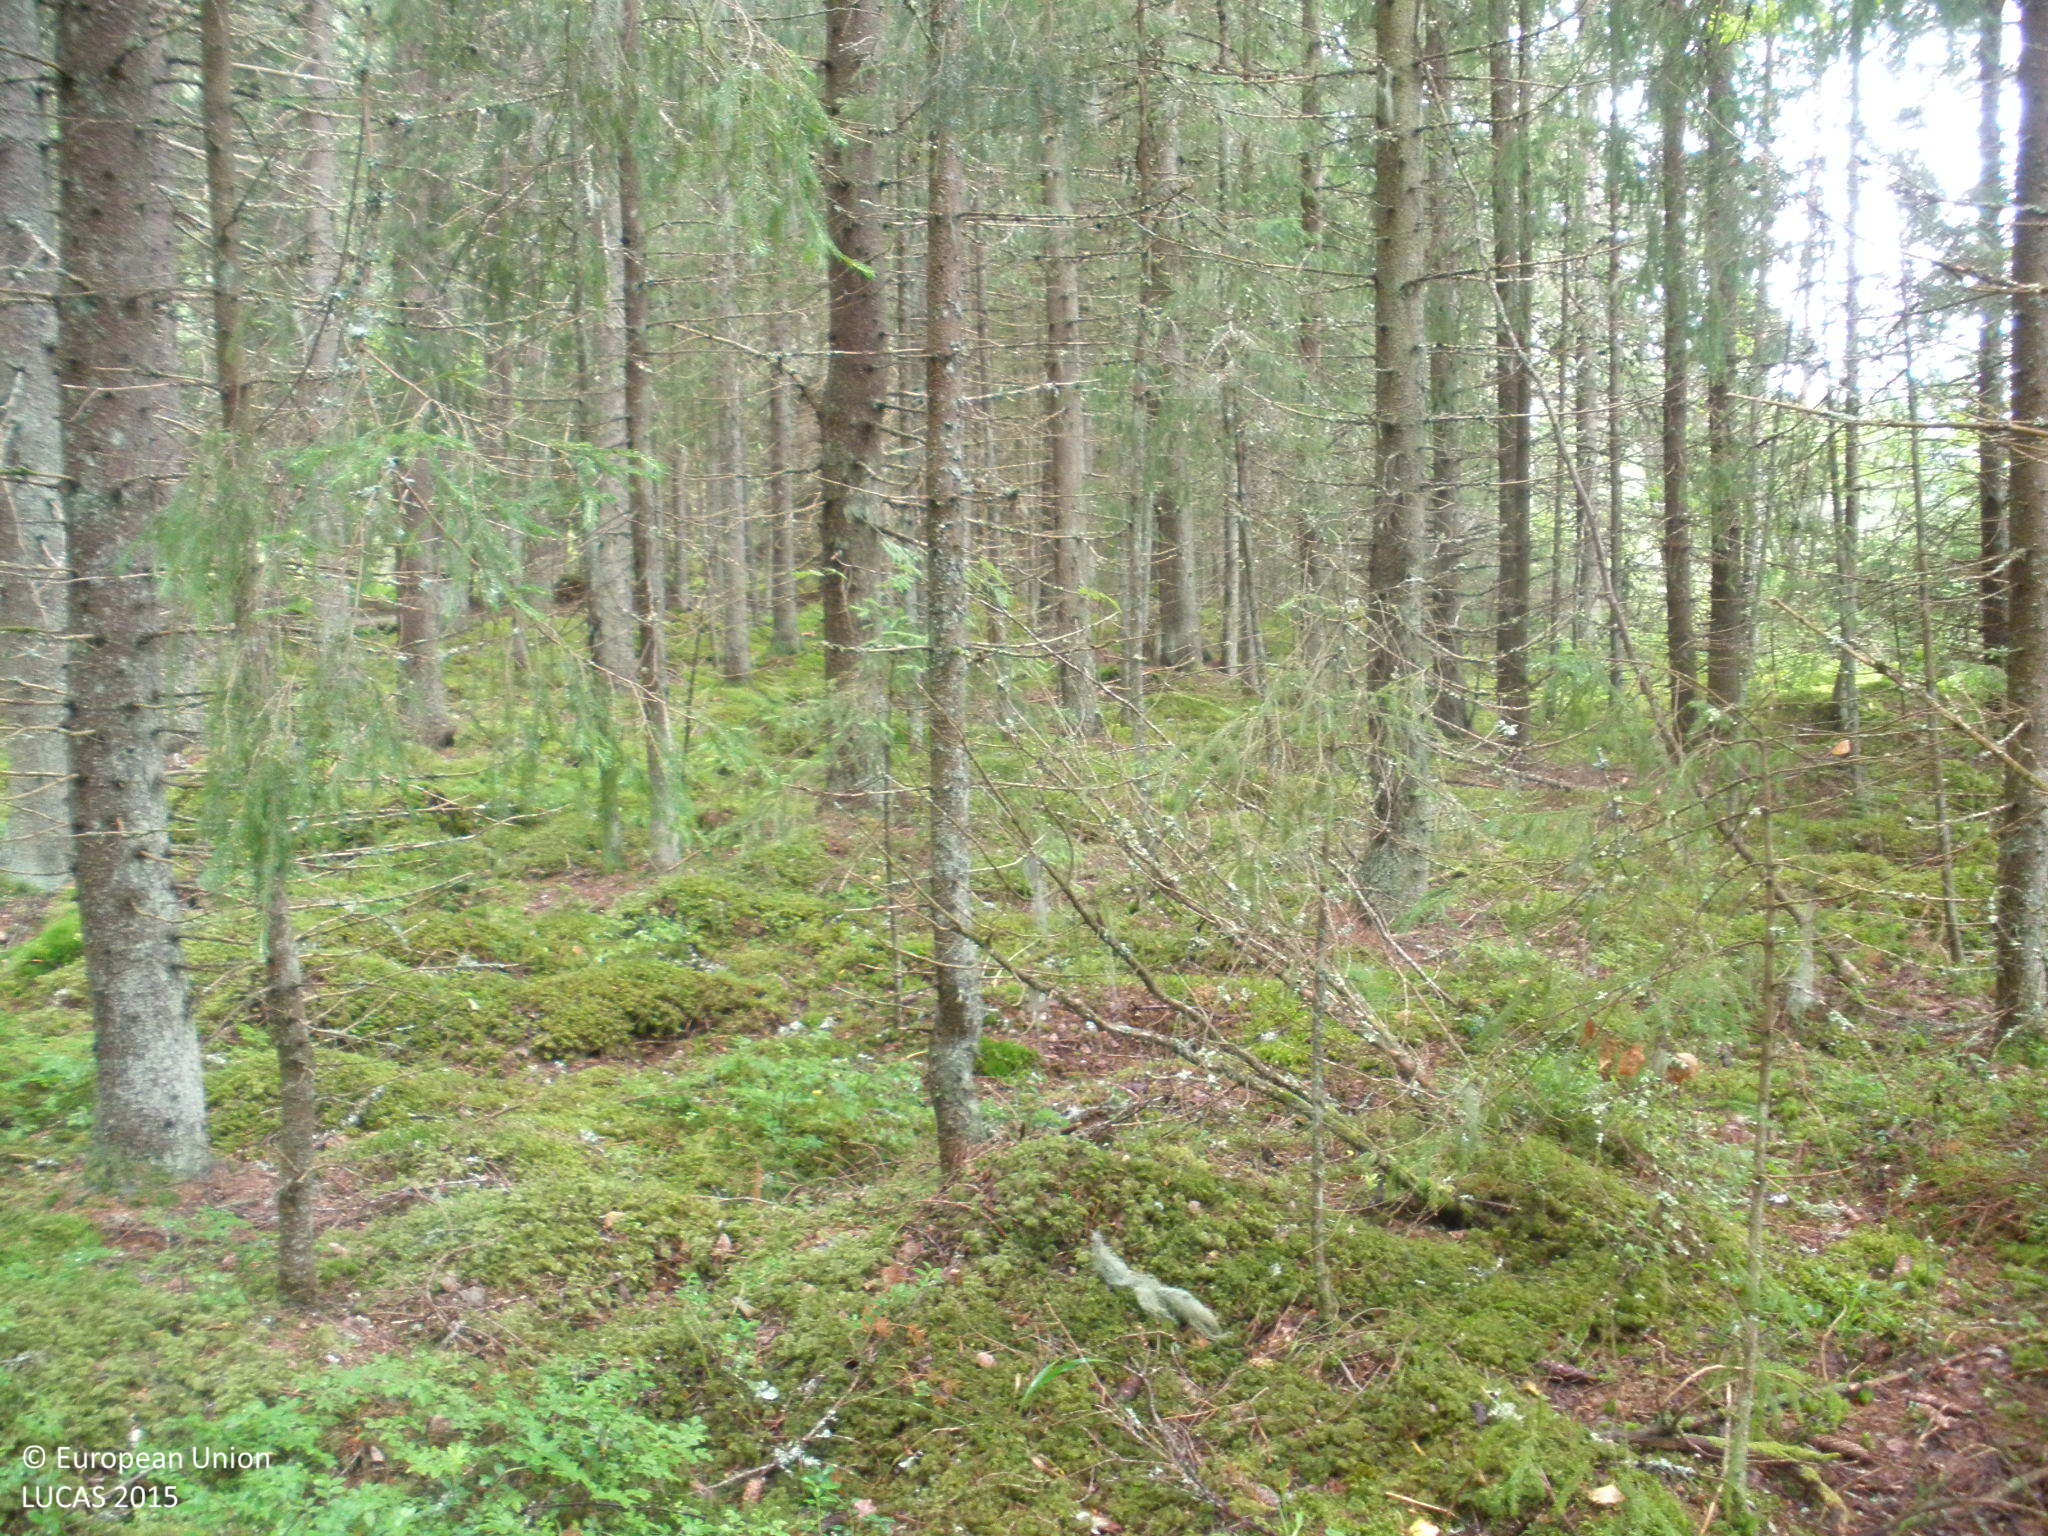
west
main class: Woodland
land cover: Spruce dominated coniferous woodland
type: boreal forest
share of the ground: > 75 %
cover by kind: coniferous forest trees 95 %, lichens and mosses 5 %
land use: Forestry
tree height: > 5 m
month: July
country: FI
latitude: 60.6732
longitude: 23.3899
